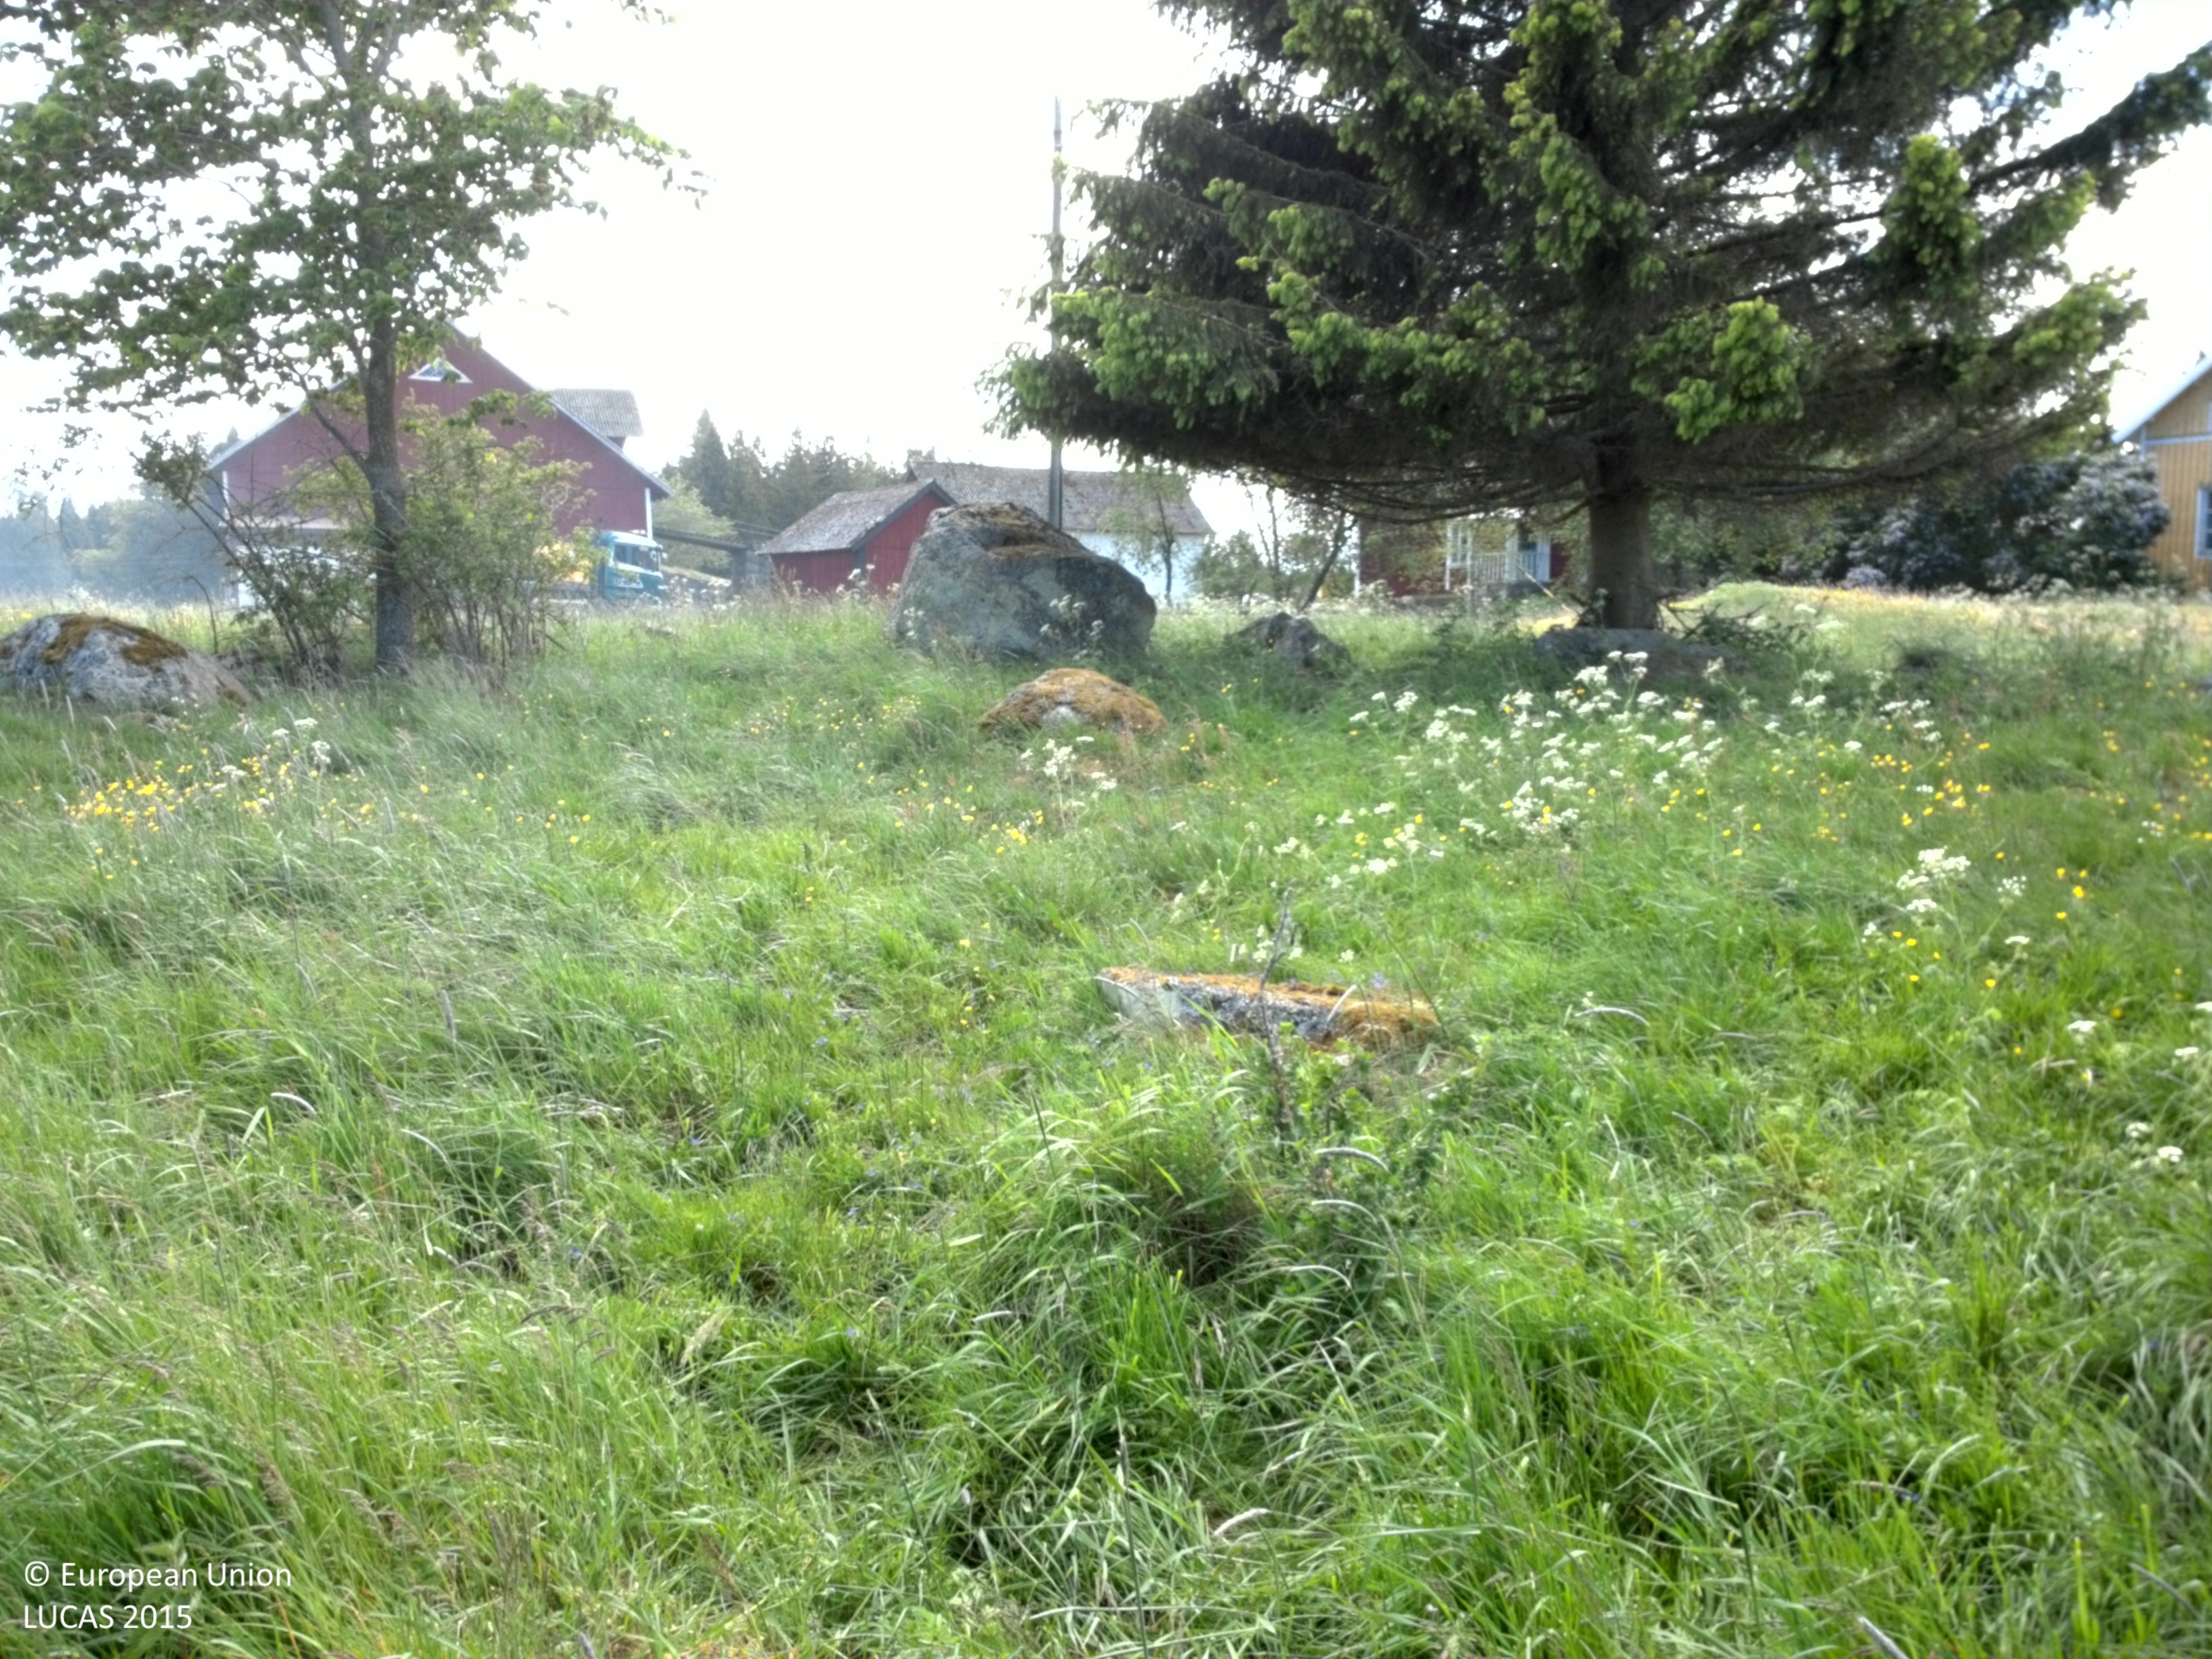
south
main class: Grassland
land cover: Grassland with sparse tree/shrub cover
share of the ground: > 75 %
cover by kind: herbaceous plants 90 %, broadleaved forest trees 5 %, shrubs 5 %
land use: Agriculture (excluding fallow land and kitchen gardens)
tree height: > 5 m
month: June
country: SE
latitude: 58.4744
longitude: 15.7731
